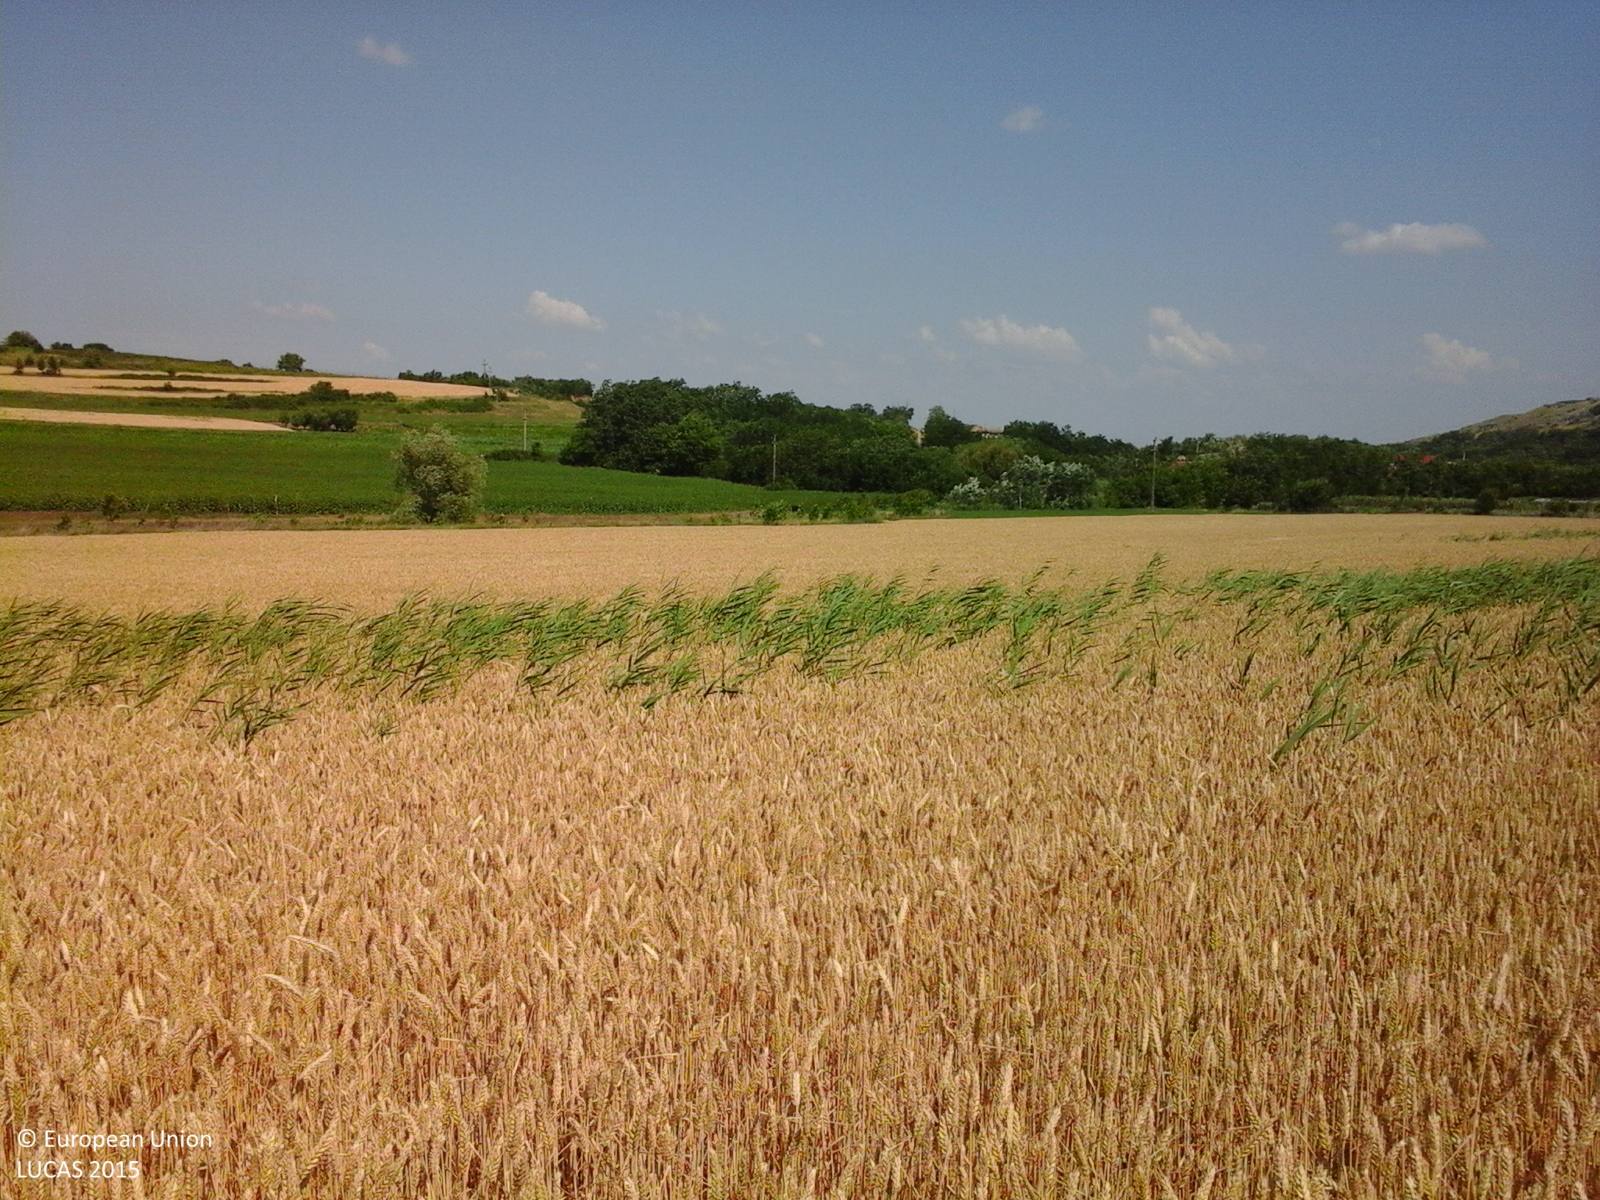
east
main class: Cropland
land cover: Common wheat
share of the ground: > 75 %
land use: Agriculture (excluding fallow land and kitchen gardens)
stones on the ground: < 10 %
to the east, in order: Common wheat; Grassland with sparse tree/shrub cover; Abandoned hedges; Rivers and streams; Shruby margins; Tracks; Sunflower
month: June
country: RO
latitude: 46.8620
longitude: 28.0630
